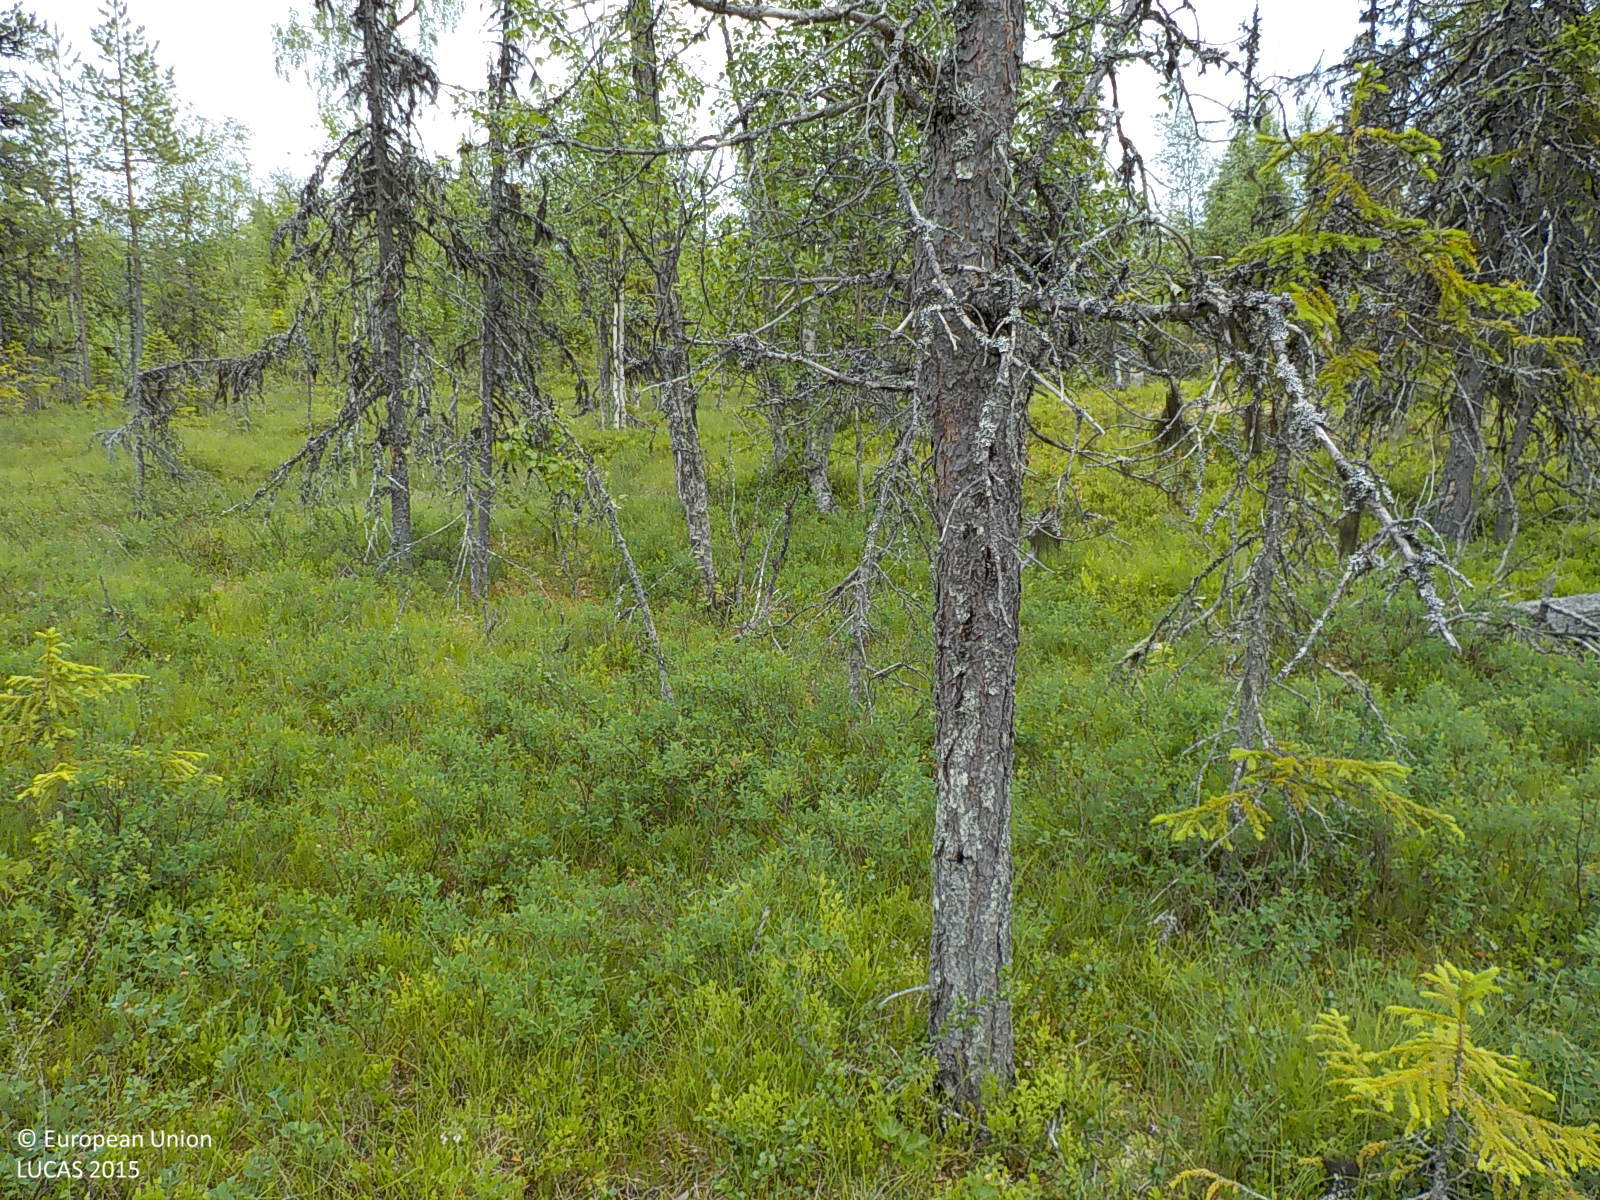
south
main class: Woodland
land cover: Spruce dominated coniferous woodland
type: boreal forest
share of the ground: 50 - 75 %
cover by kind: coniferous forest trees 50 %, shrubs 25 %, herbaceous plants 20 %, broadleaved forest trees 5 %
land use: Semi-natural and natural areas not in use
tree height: < 5 m
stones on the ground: < 10 %
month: July
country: SE
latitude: 63.1725
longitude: 16.6290
